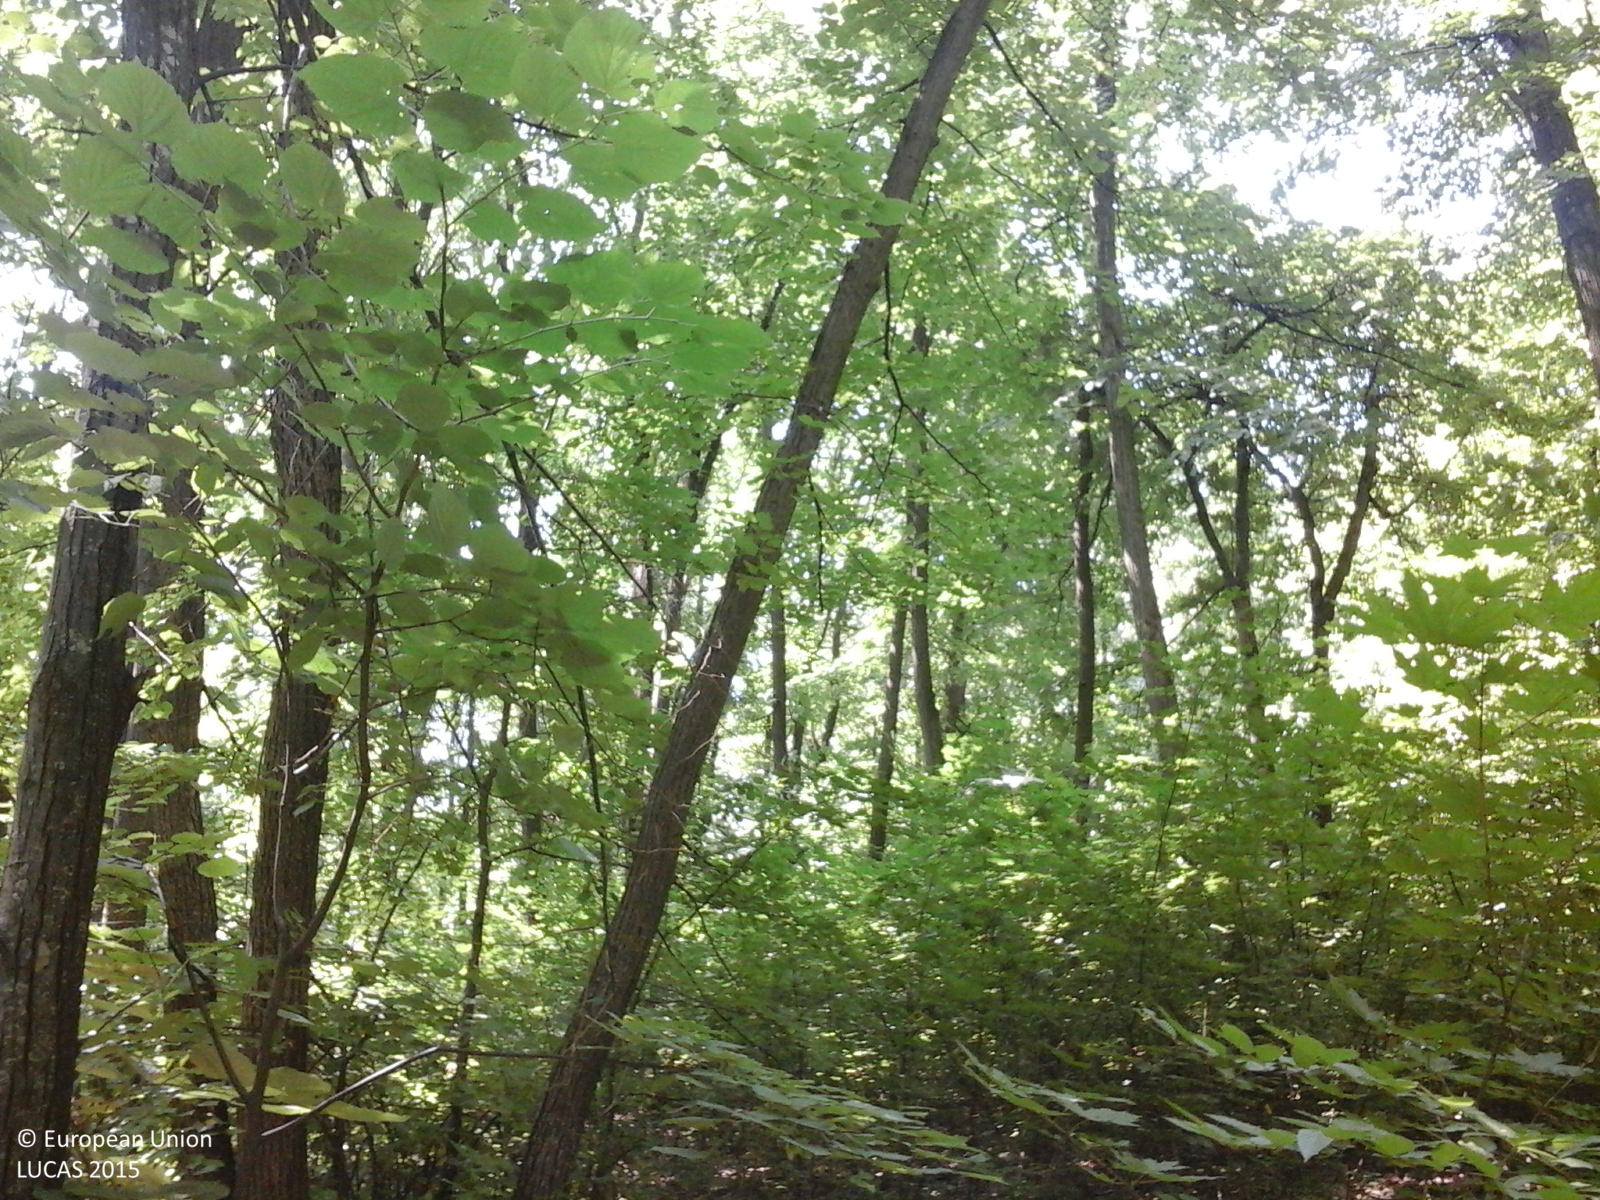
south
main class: Woodland
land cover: Broadleaved woodland
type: beech forest
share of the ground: > 75 %
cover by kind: broadleaved forest trees 90 %, shrubs 5 %, herbaceous plants 5 %
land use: Forestry
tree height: > 5 m
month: June
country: RO
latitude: 46.8204
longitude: 27.3176
